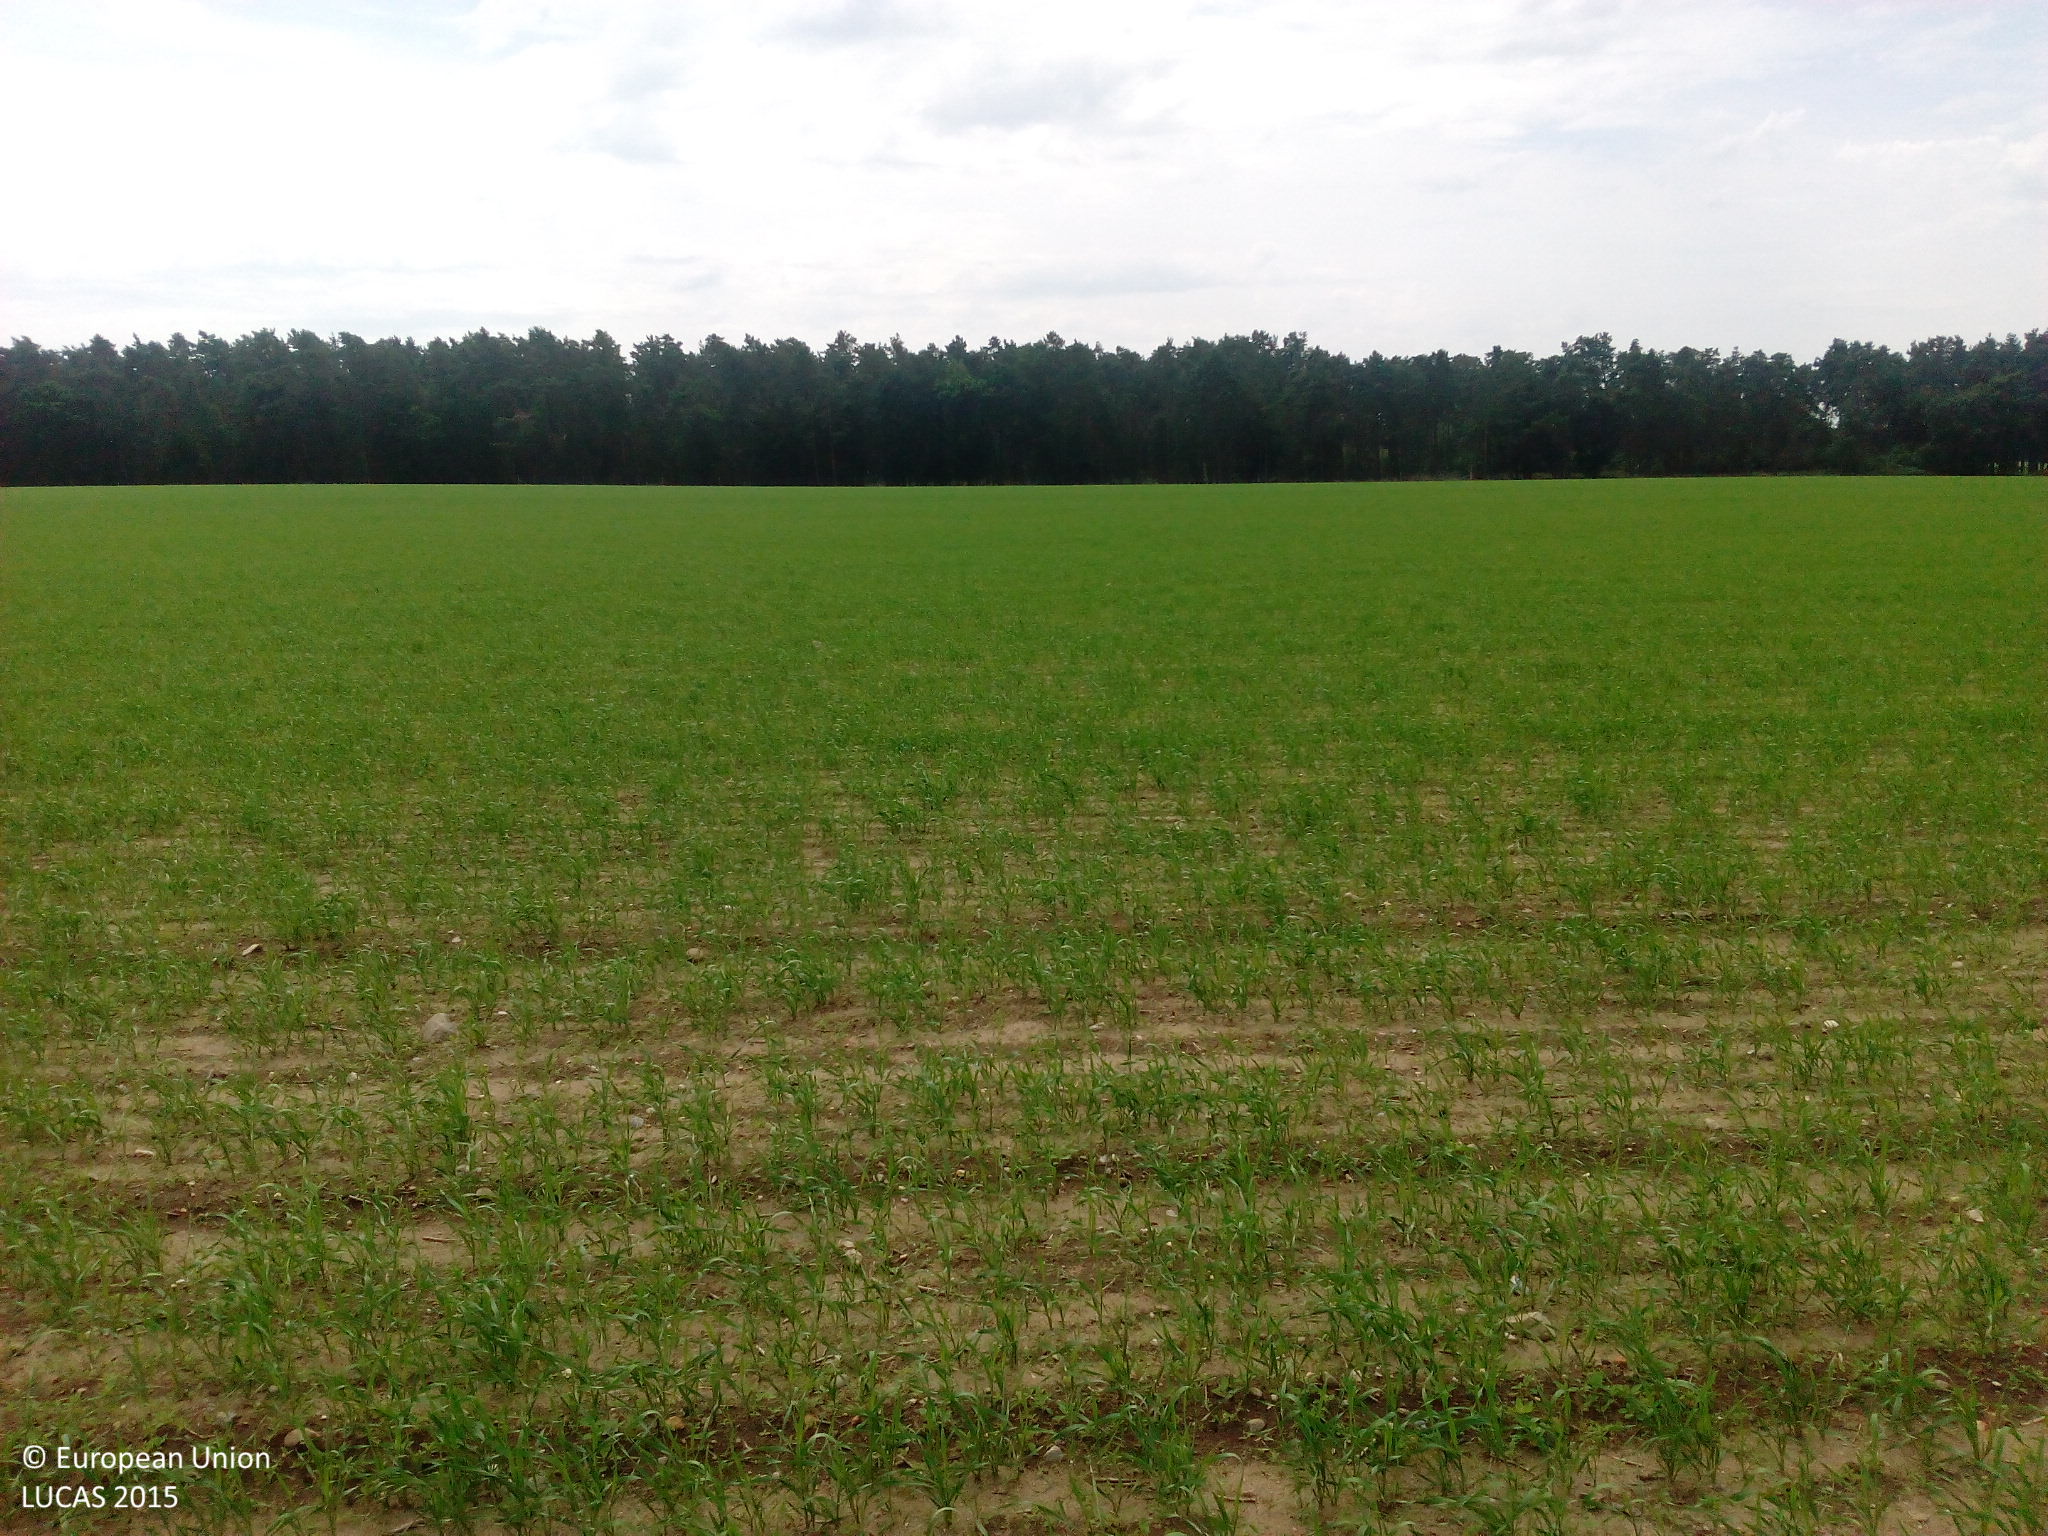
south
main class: Cropland
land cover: Common wheat
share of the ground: 25 - 50 %
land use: Agriculture (excluding fallow land and kitchen gardens)
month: July
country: DE
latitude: 52.0115
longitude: 12.4036
